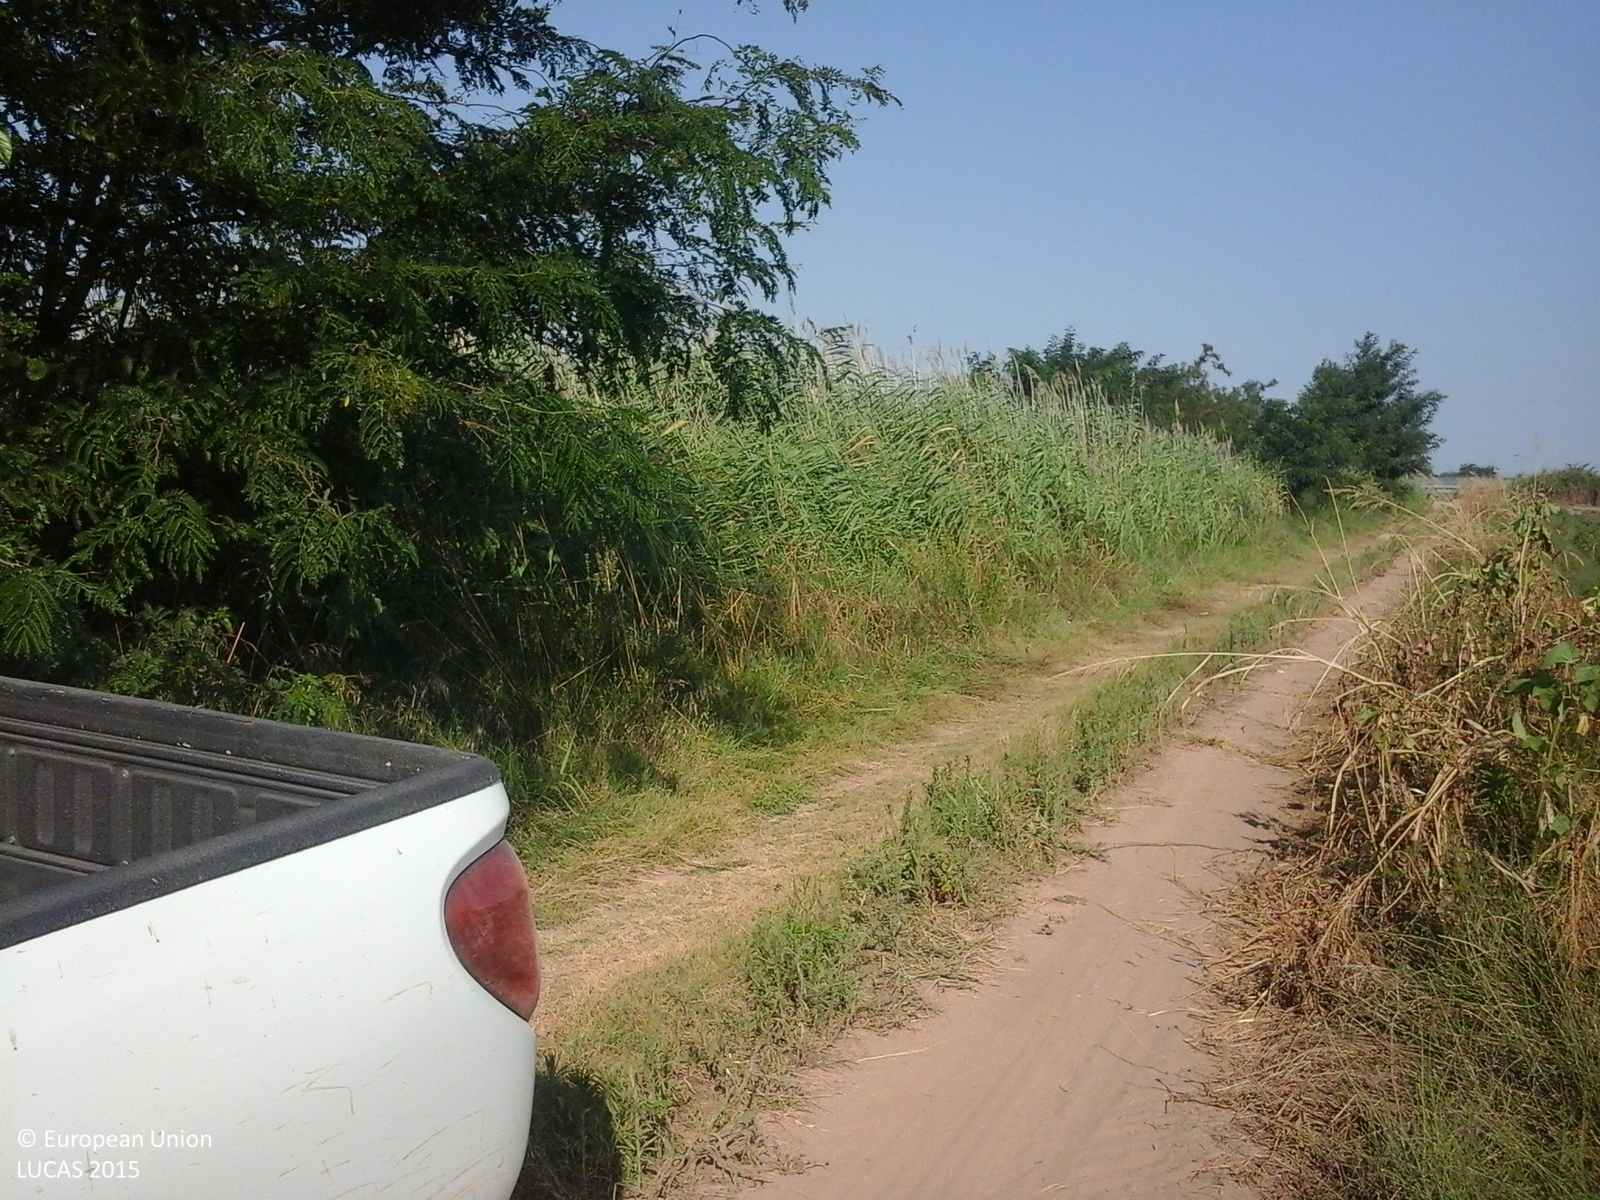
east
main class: Cropland
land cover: Other fresh vegetables
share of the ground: > 75 %
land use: Agriculture (excluding fallow land and kitchen gardens)
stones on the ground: < 10 %
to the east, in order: Other fresh vegetables; Ditches and canals; Grass margins; Tracks; Inland marshes; Clovers; Abandoned hedges; Ditches and canals; Shruby margins; Tracks; Other fresh vegetables; Cotton
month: July
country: GR
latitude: 40.7146
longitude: 22.5874
